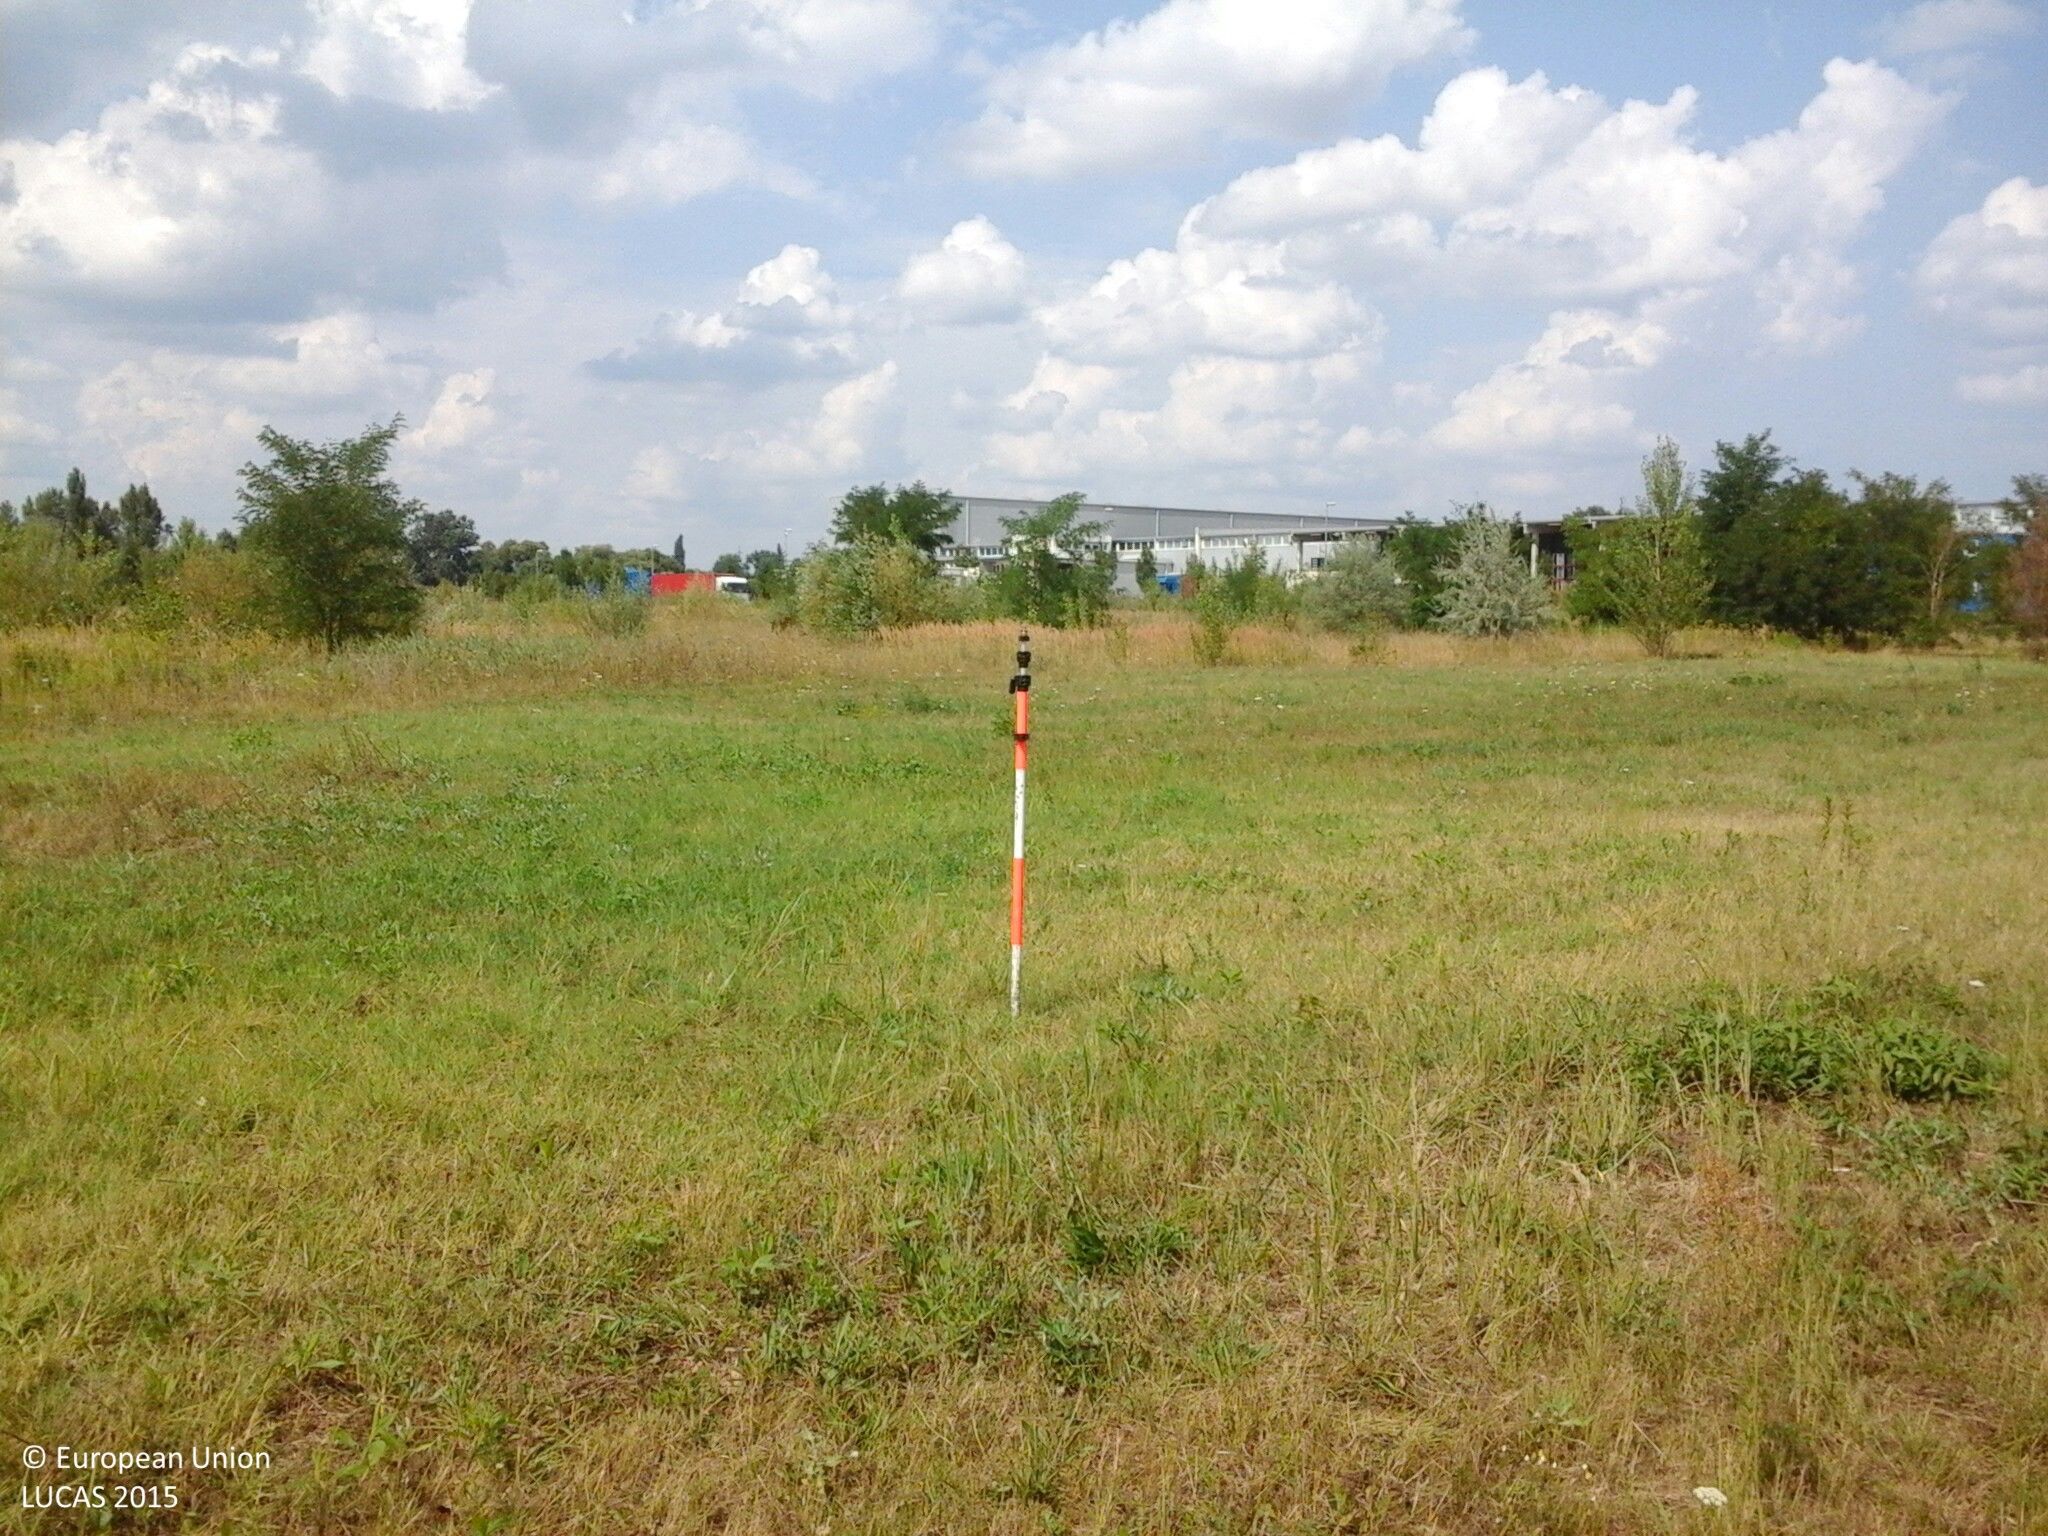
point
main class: Grassland
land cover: Grassland without tree/shrub cover
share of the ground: > 75 %
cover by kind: herbaceous plants 100 %
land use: Semi-natural and natural areas not in use
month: August
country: HU
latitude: 47.3763
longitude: 18.1831
